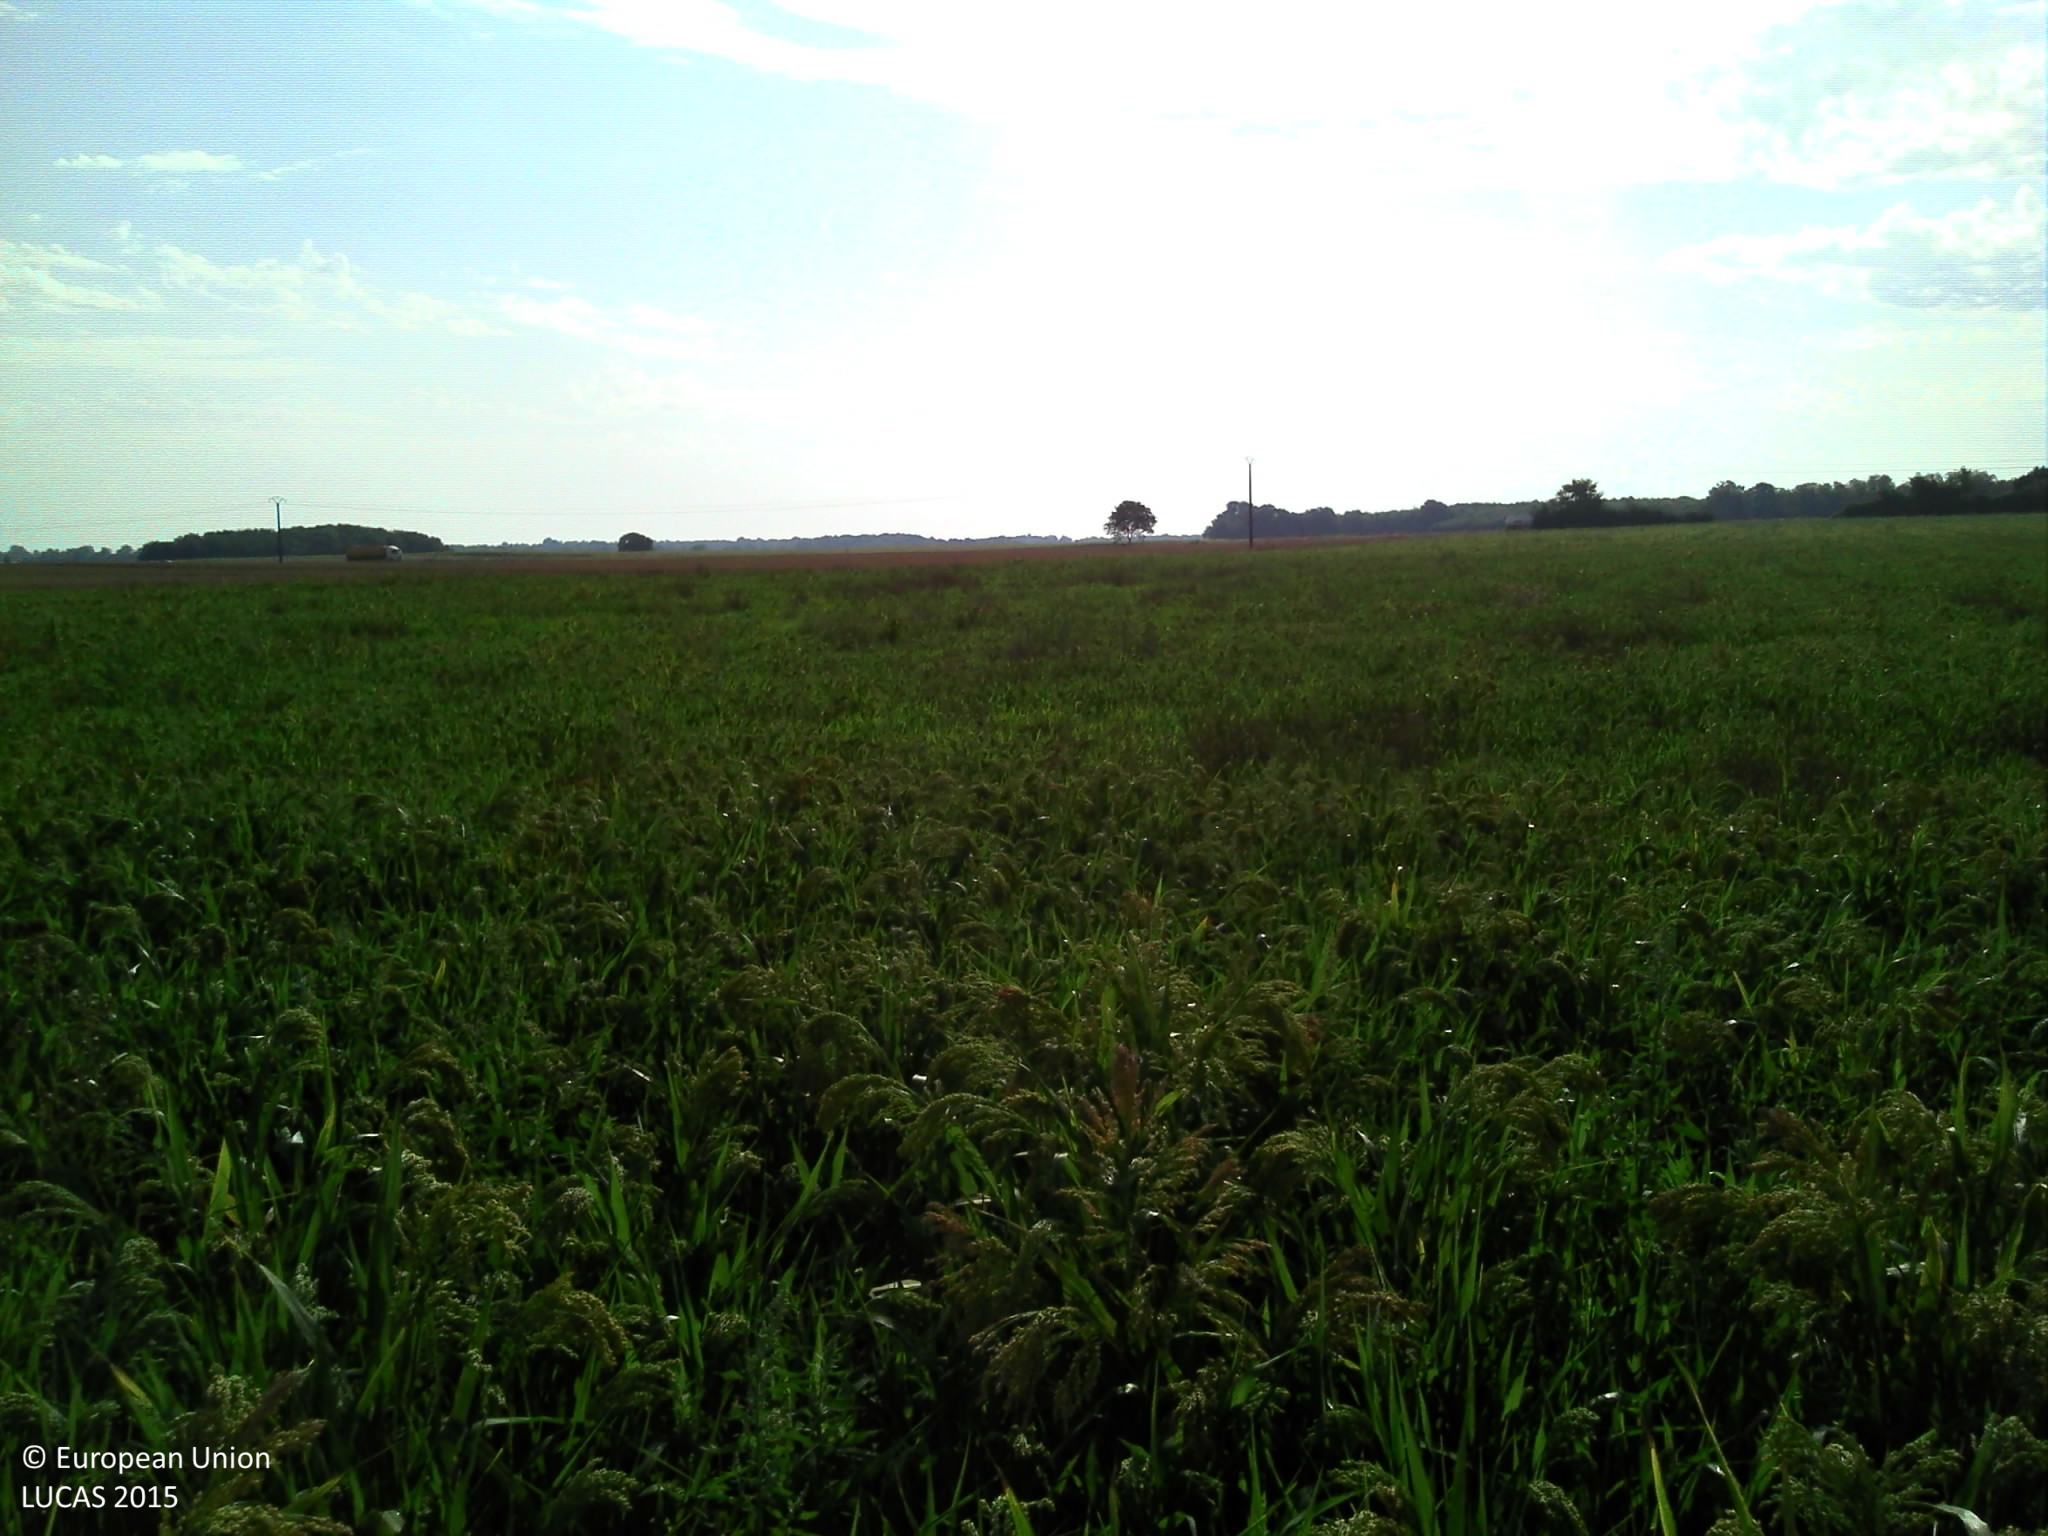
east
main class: Cropland
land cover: Other cereals
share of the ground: > 75 %
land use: Agriculture (excluding fallow land and kitchen gardens)
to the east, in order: Other cereals; Common wheat; Electric lines; Common wheat; Ditches and canals; Grass margins; Paved roads, cycling and walking lanes; Grass margins; Ditches and canals; Other bare soil
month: August
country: FR
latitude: 46.1819
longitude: 0.3050
